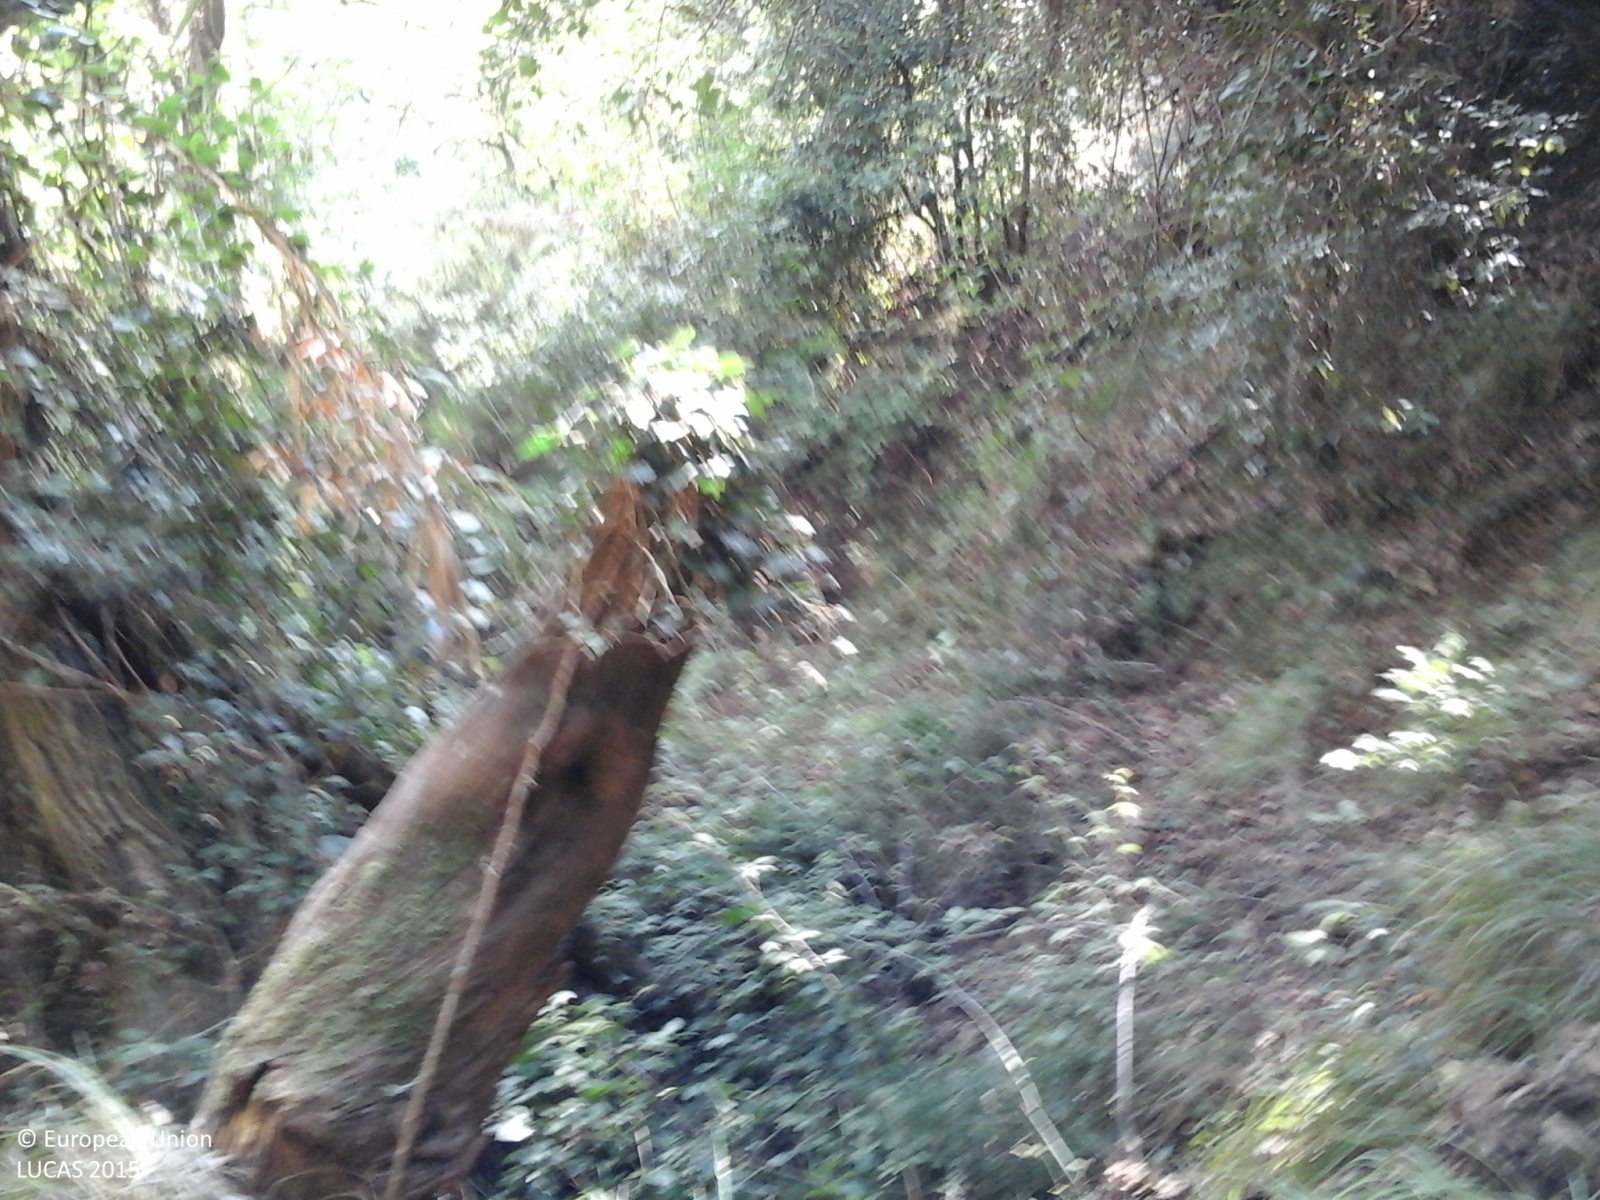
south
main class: Woodland
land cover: Broadleaved woodland
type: thermophilous deciduous forest
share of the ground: > 75 %
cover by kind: broadleaved forest trees 80 %, shrubs 10 %, herbaceous plants 10 %
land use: Semi-natural and natural areas not in use
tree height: > 5 m
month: September
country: IT
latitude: 44.3395
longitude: 8.4858
